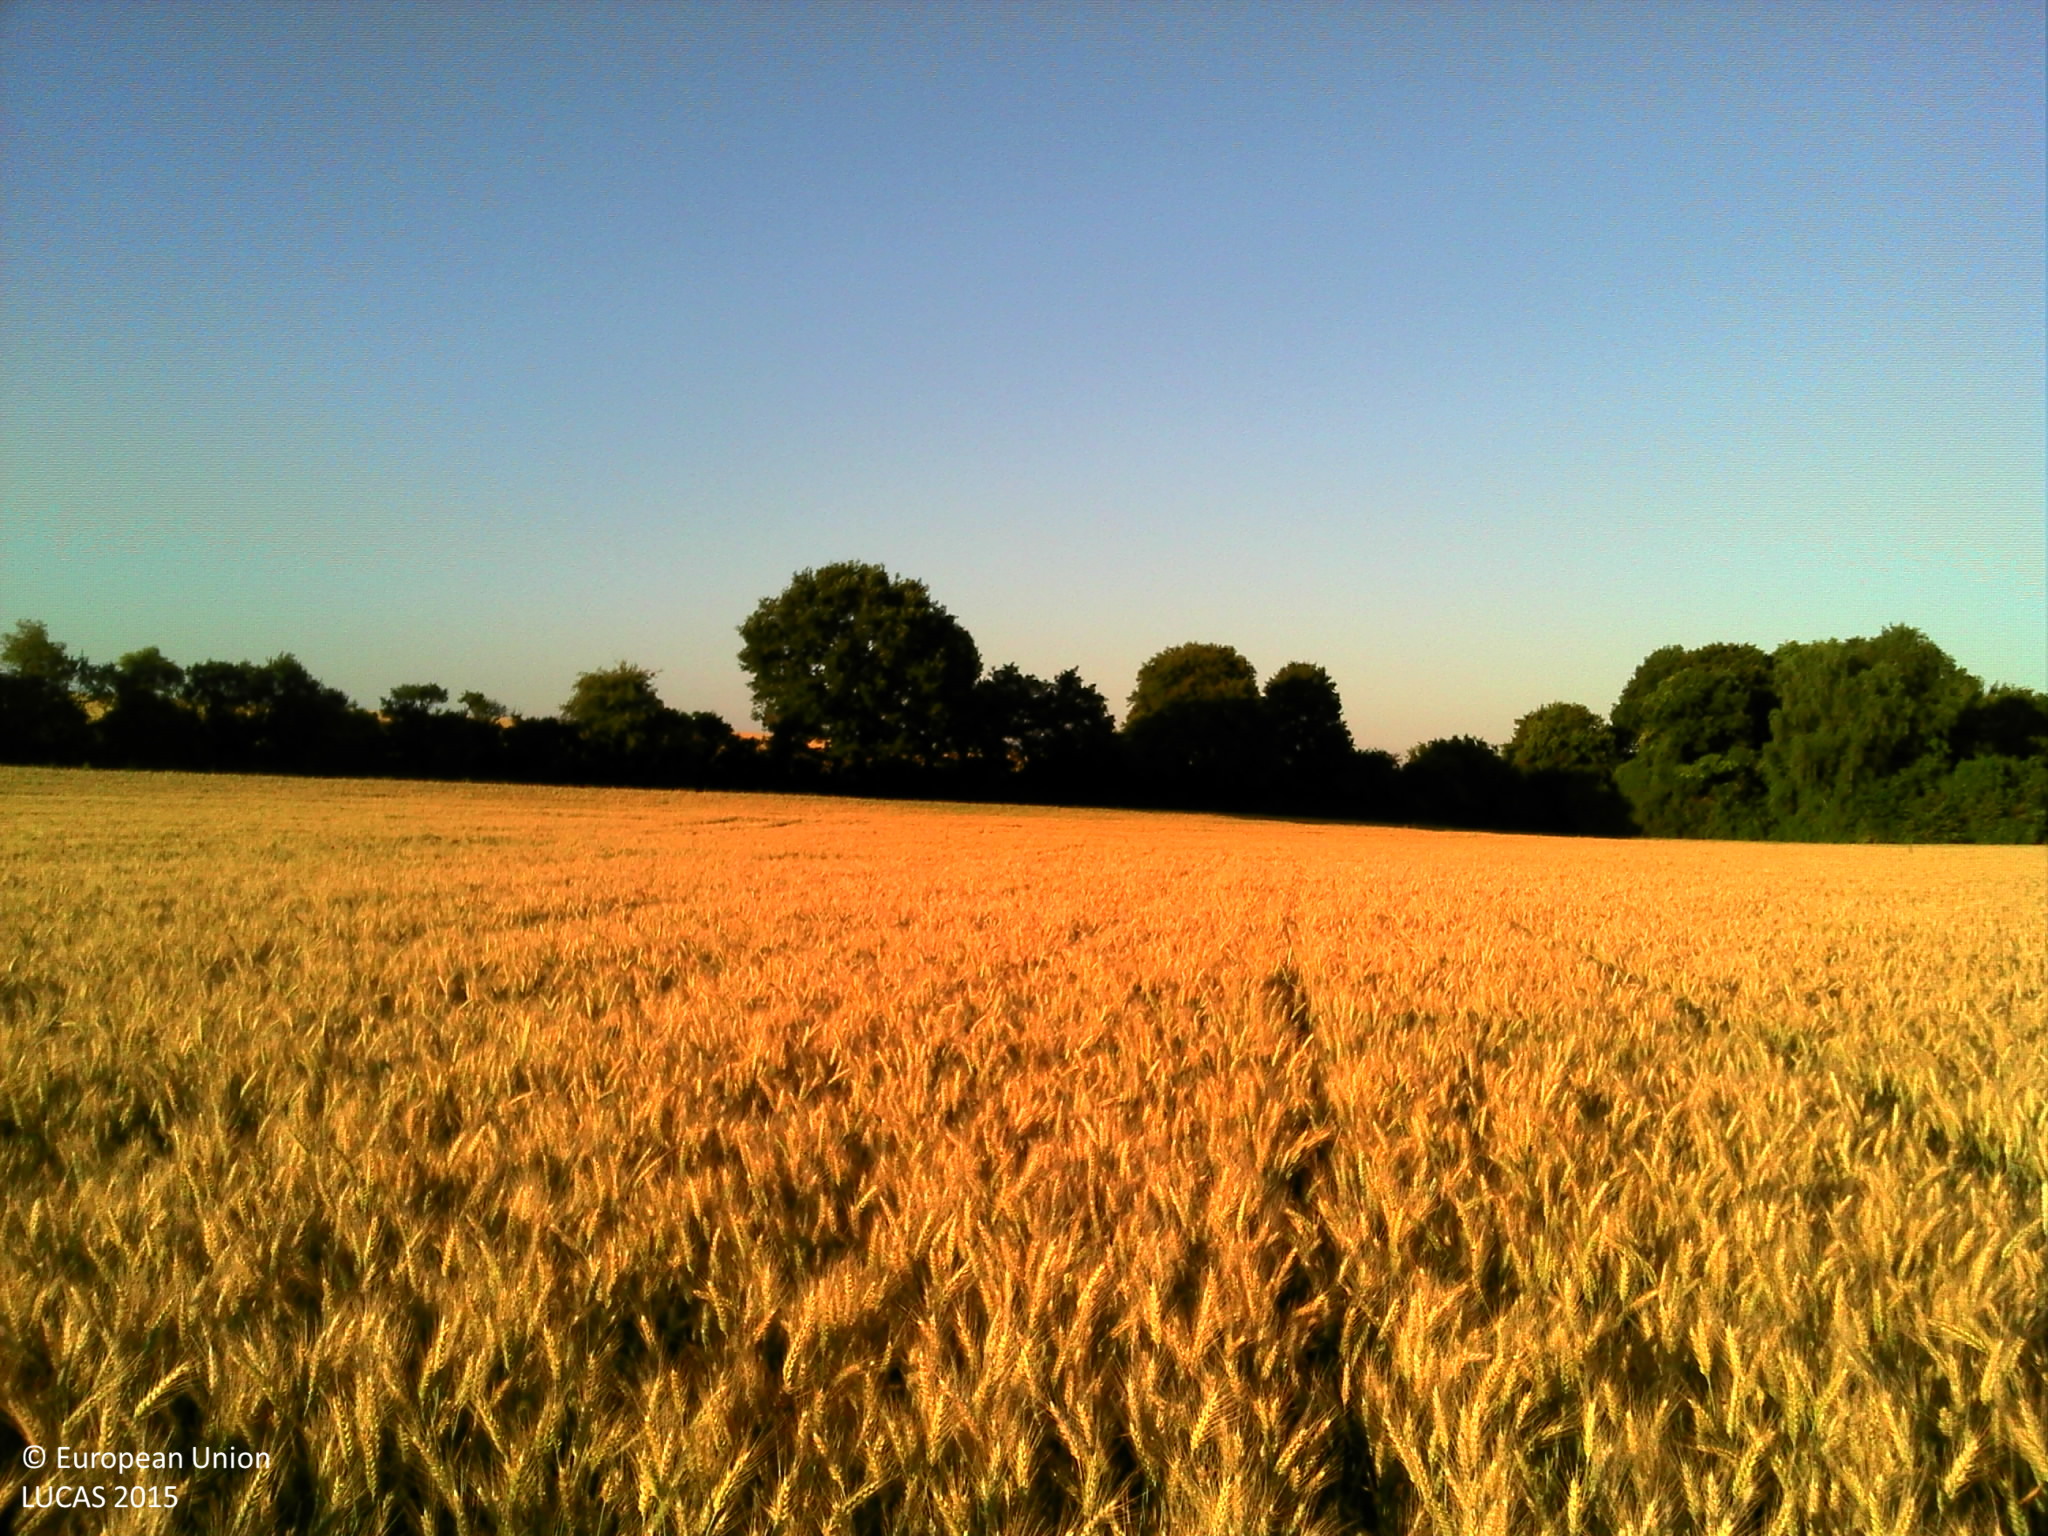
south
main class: Cropland
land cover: Common wheat
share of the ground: > 75 %
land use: Agriculture (excluding fallow land and kitchen gardens)
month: June
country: FR
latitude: 49.4277
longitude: 2.4459
